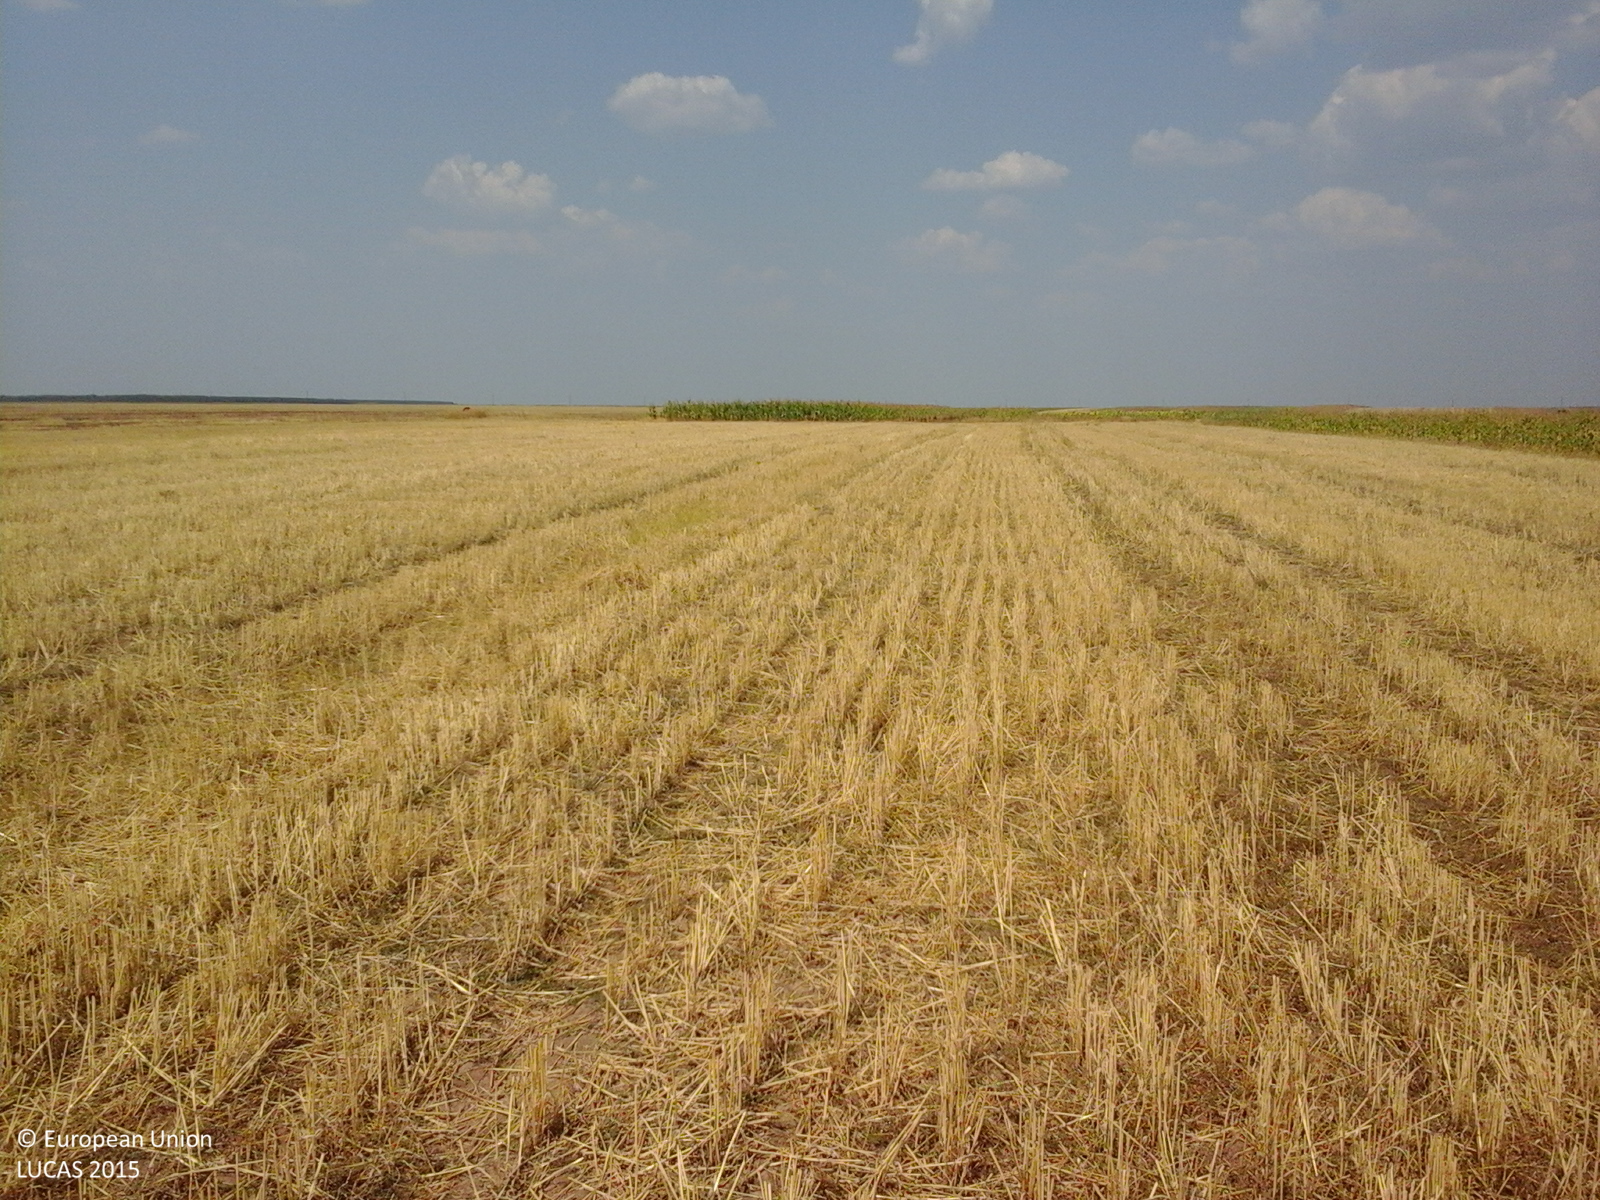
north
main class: Cropland
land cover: Durum wheat
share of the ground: > 75 %
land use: Agriculture (excluding fallow land and kitchen gardens)
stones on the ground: < 10 %
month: August
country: RO
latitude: 44.3903
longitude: 23.1145
